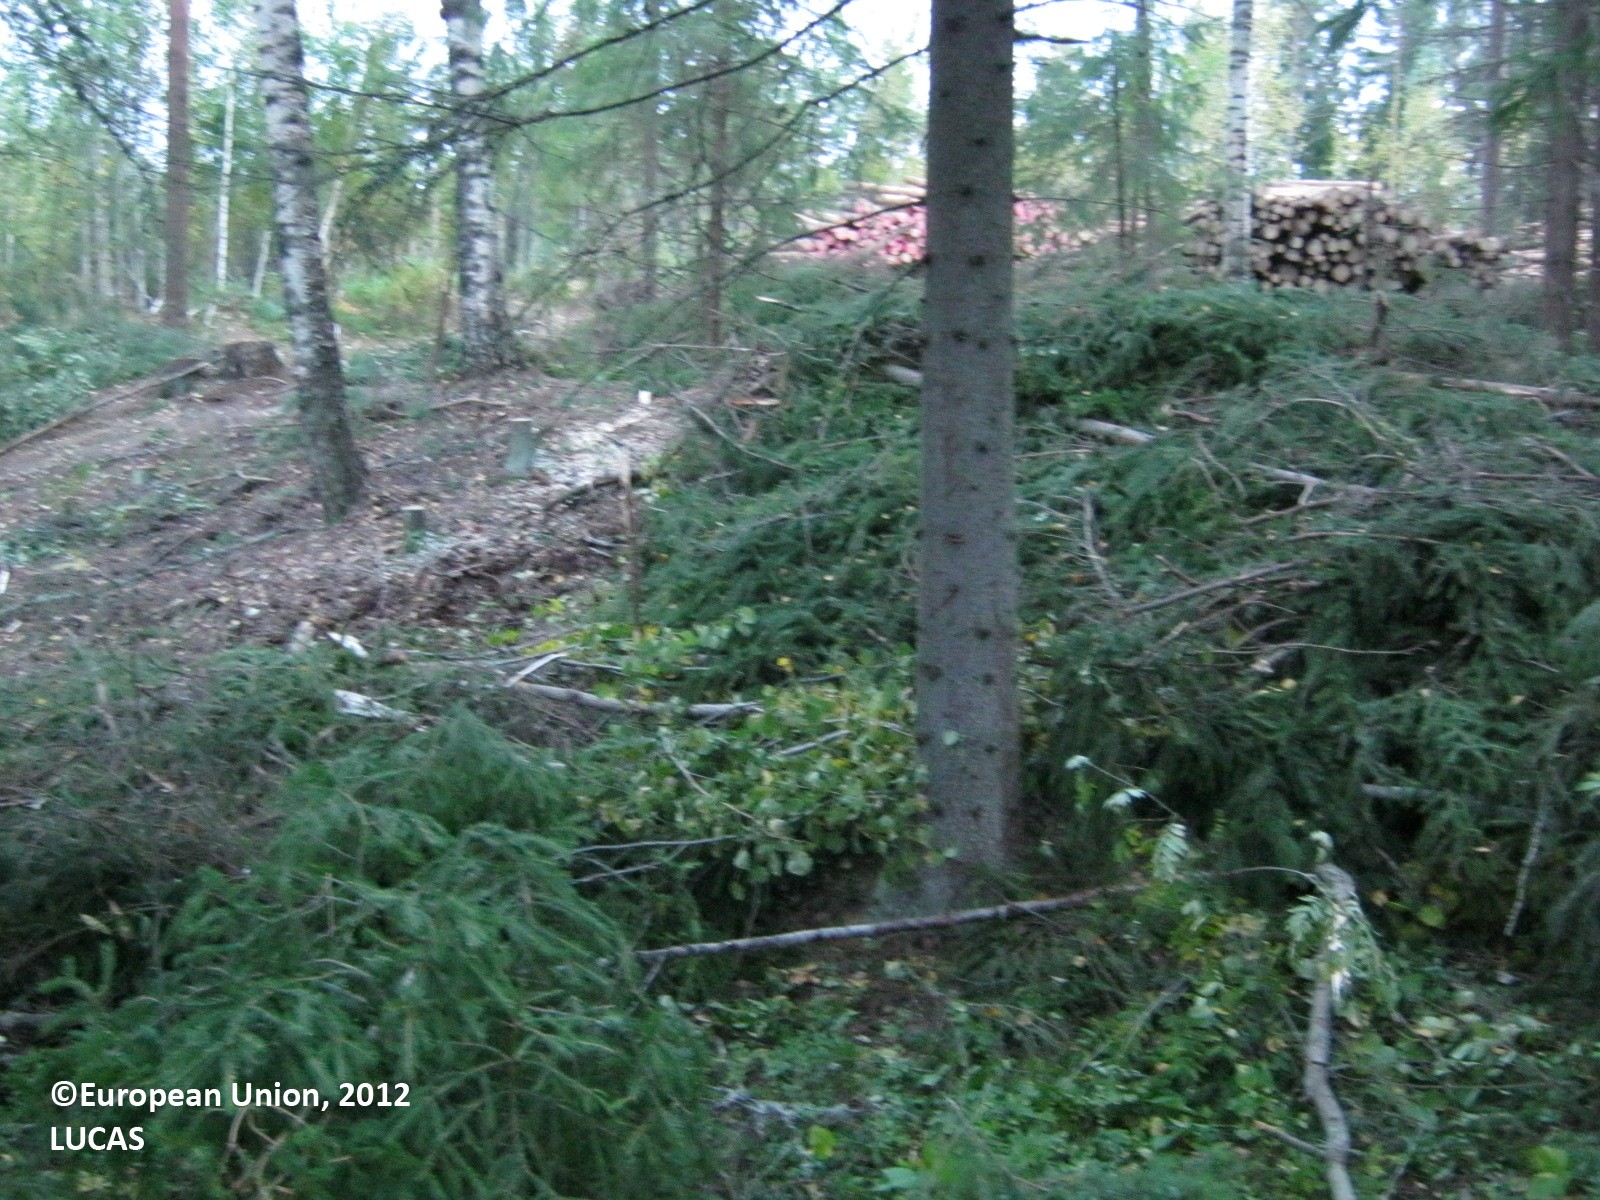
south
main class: Woodland
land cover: Broadleaved woodland
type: boreal forest
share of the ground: > 75 %
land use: Forestry
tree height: > 5 m
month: September
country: FI
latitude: 60.7275
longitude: 27.8900
